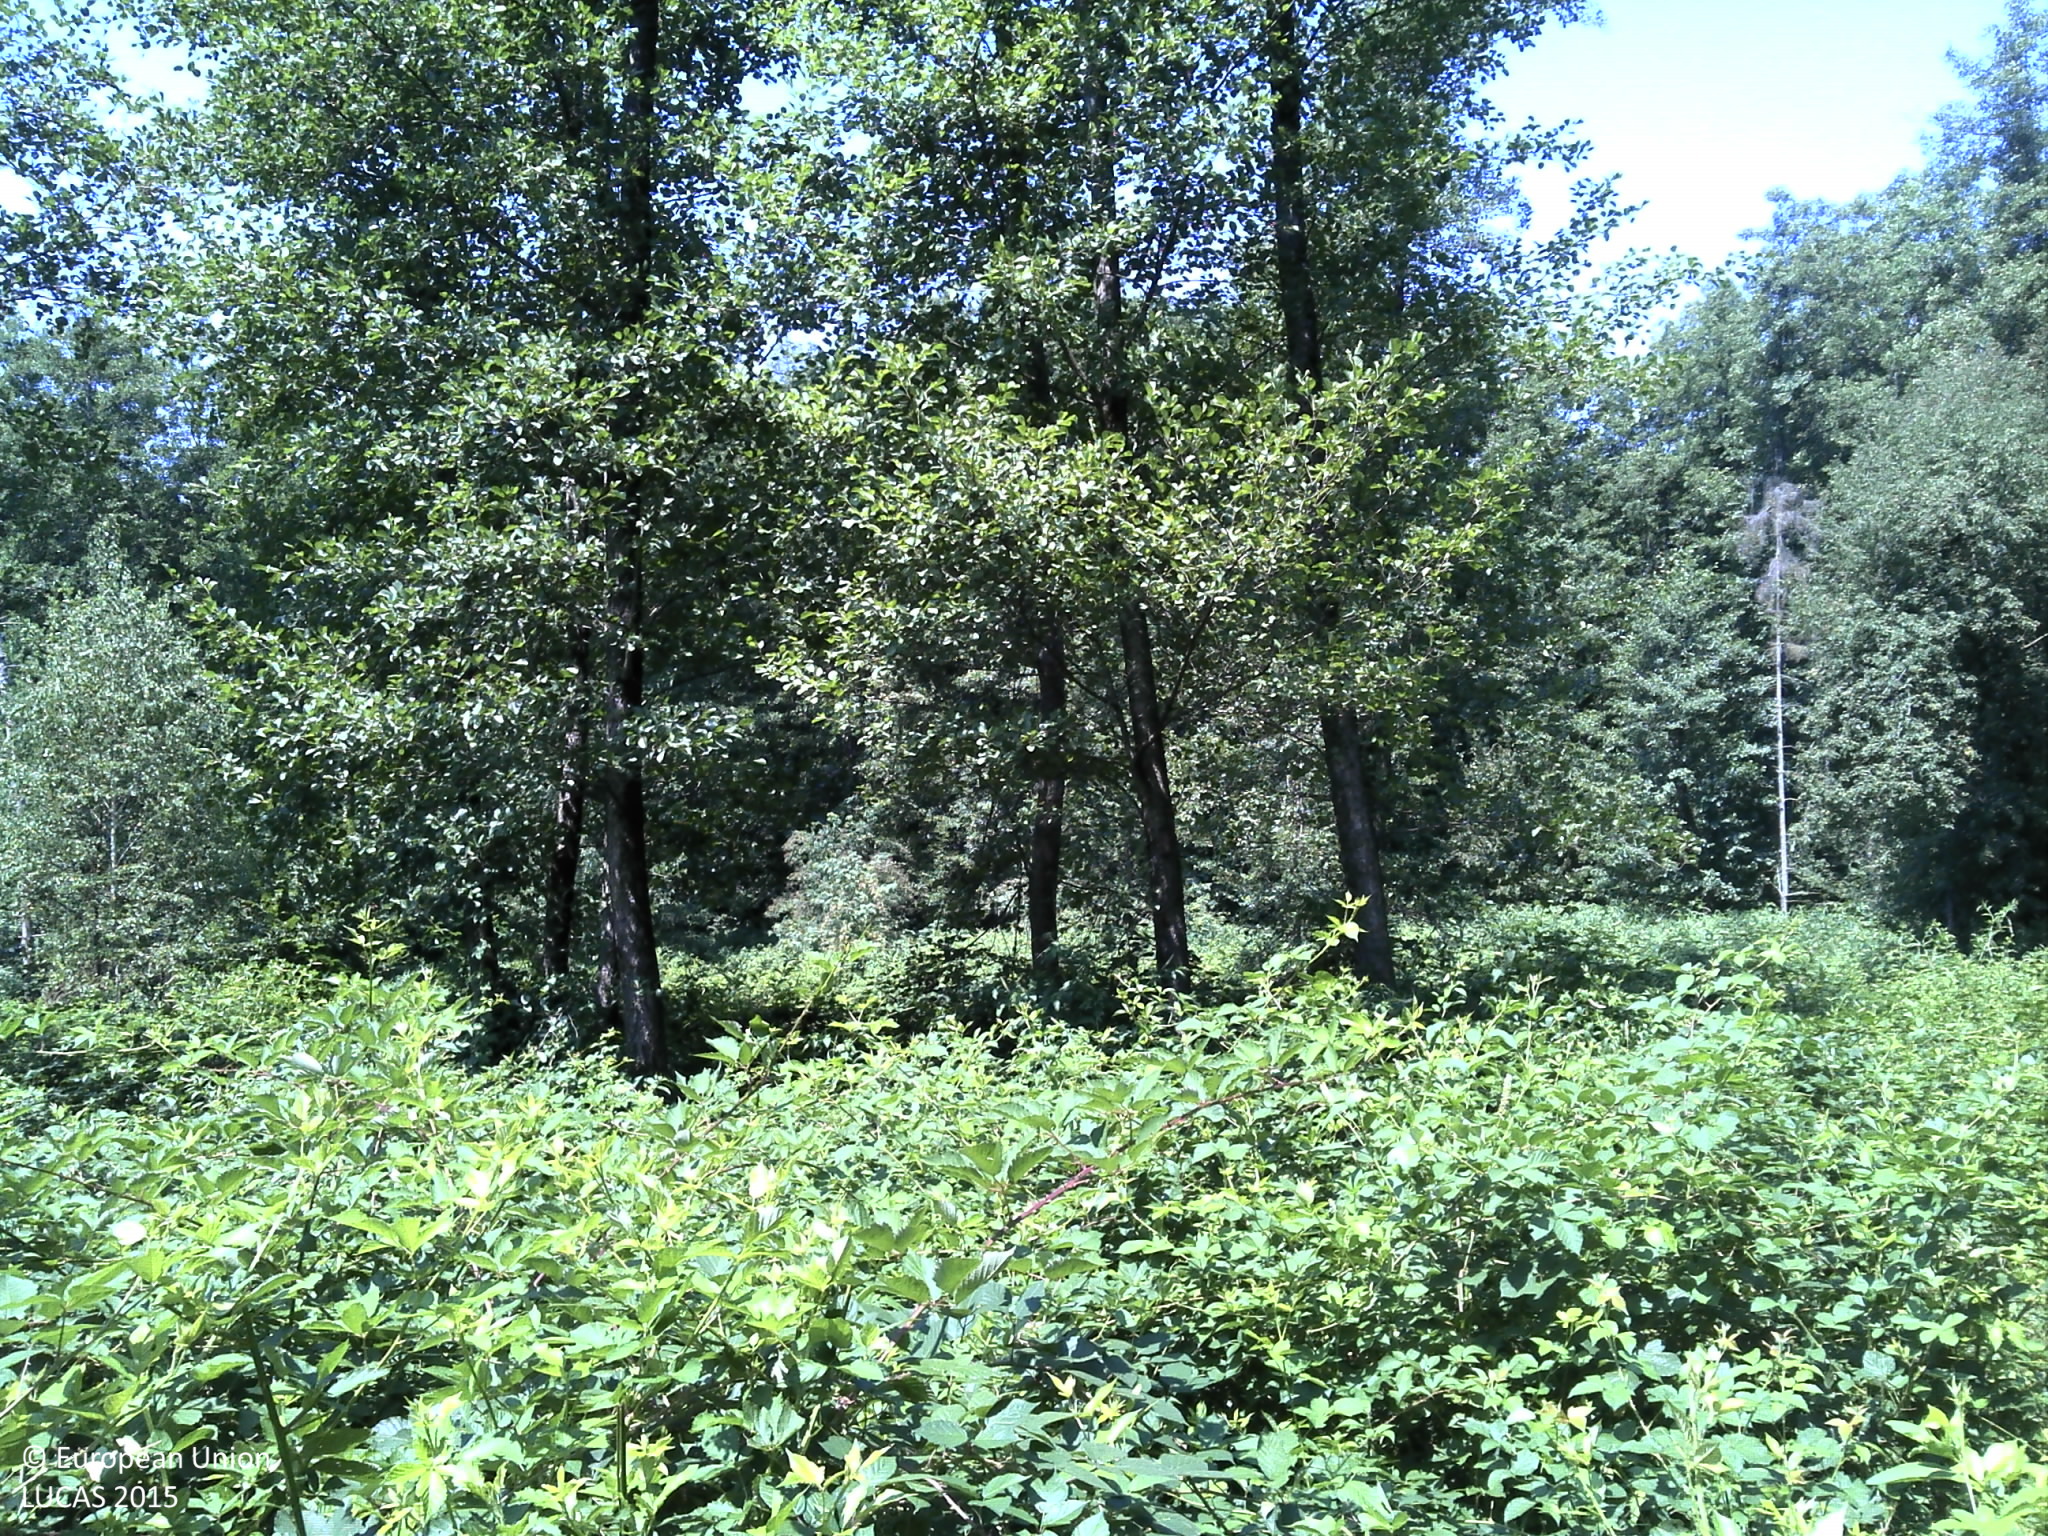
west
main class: Shrubland
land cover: Shrubland with sparse tree cover
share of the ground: > 75 %
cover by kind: shrubs 95 %, broadleaved forest trees 5 %
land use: Forestry
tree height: < 5 m
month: July
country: HR
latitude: 45.5969
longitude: 16.7295
